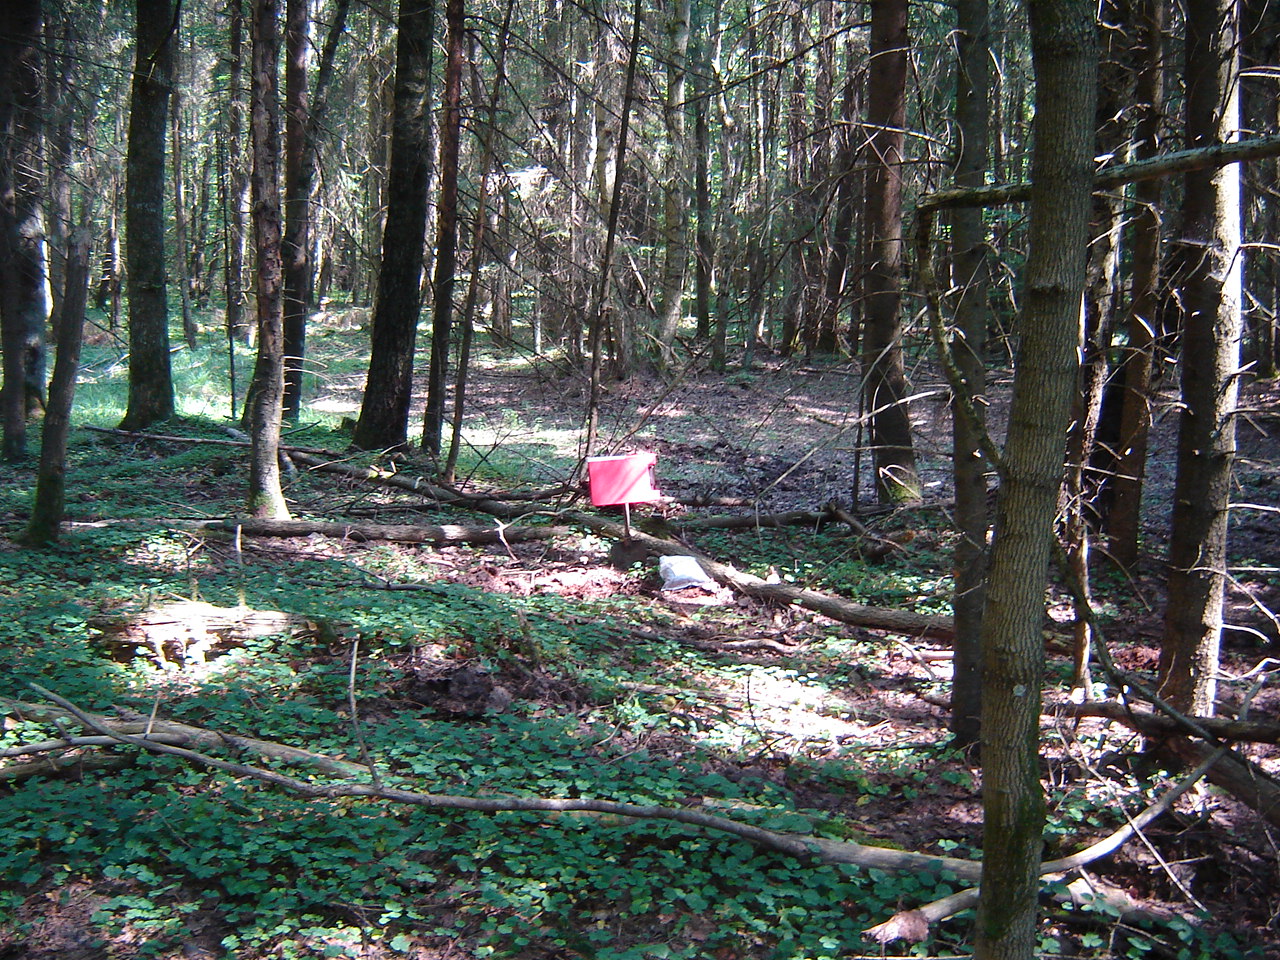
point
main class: Woodland
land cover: Spruce dominated mixed woodland
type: hemiboreal forest and nemoral coniferous forest and mixed broadleaved-coniferous forest
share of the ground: > 75 %
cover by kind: coniferous forest trees 60 %, broadleaved forest trees 30 %, herbaceous plants 5 %, unconsolidated bare surface 5 %
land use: Forestry
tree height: > 5 m
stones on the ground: < 10 %
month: August
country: LT
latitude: 55.1866
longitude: 25.0184
